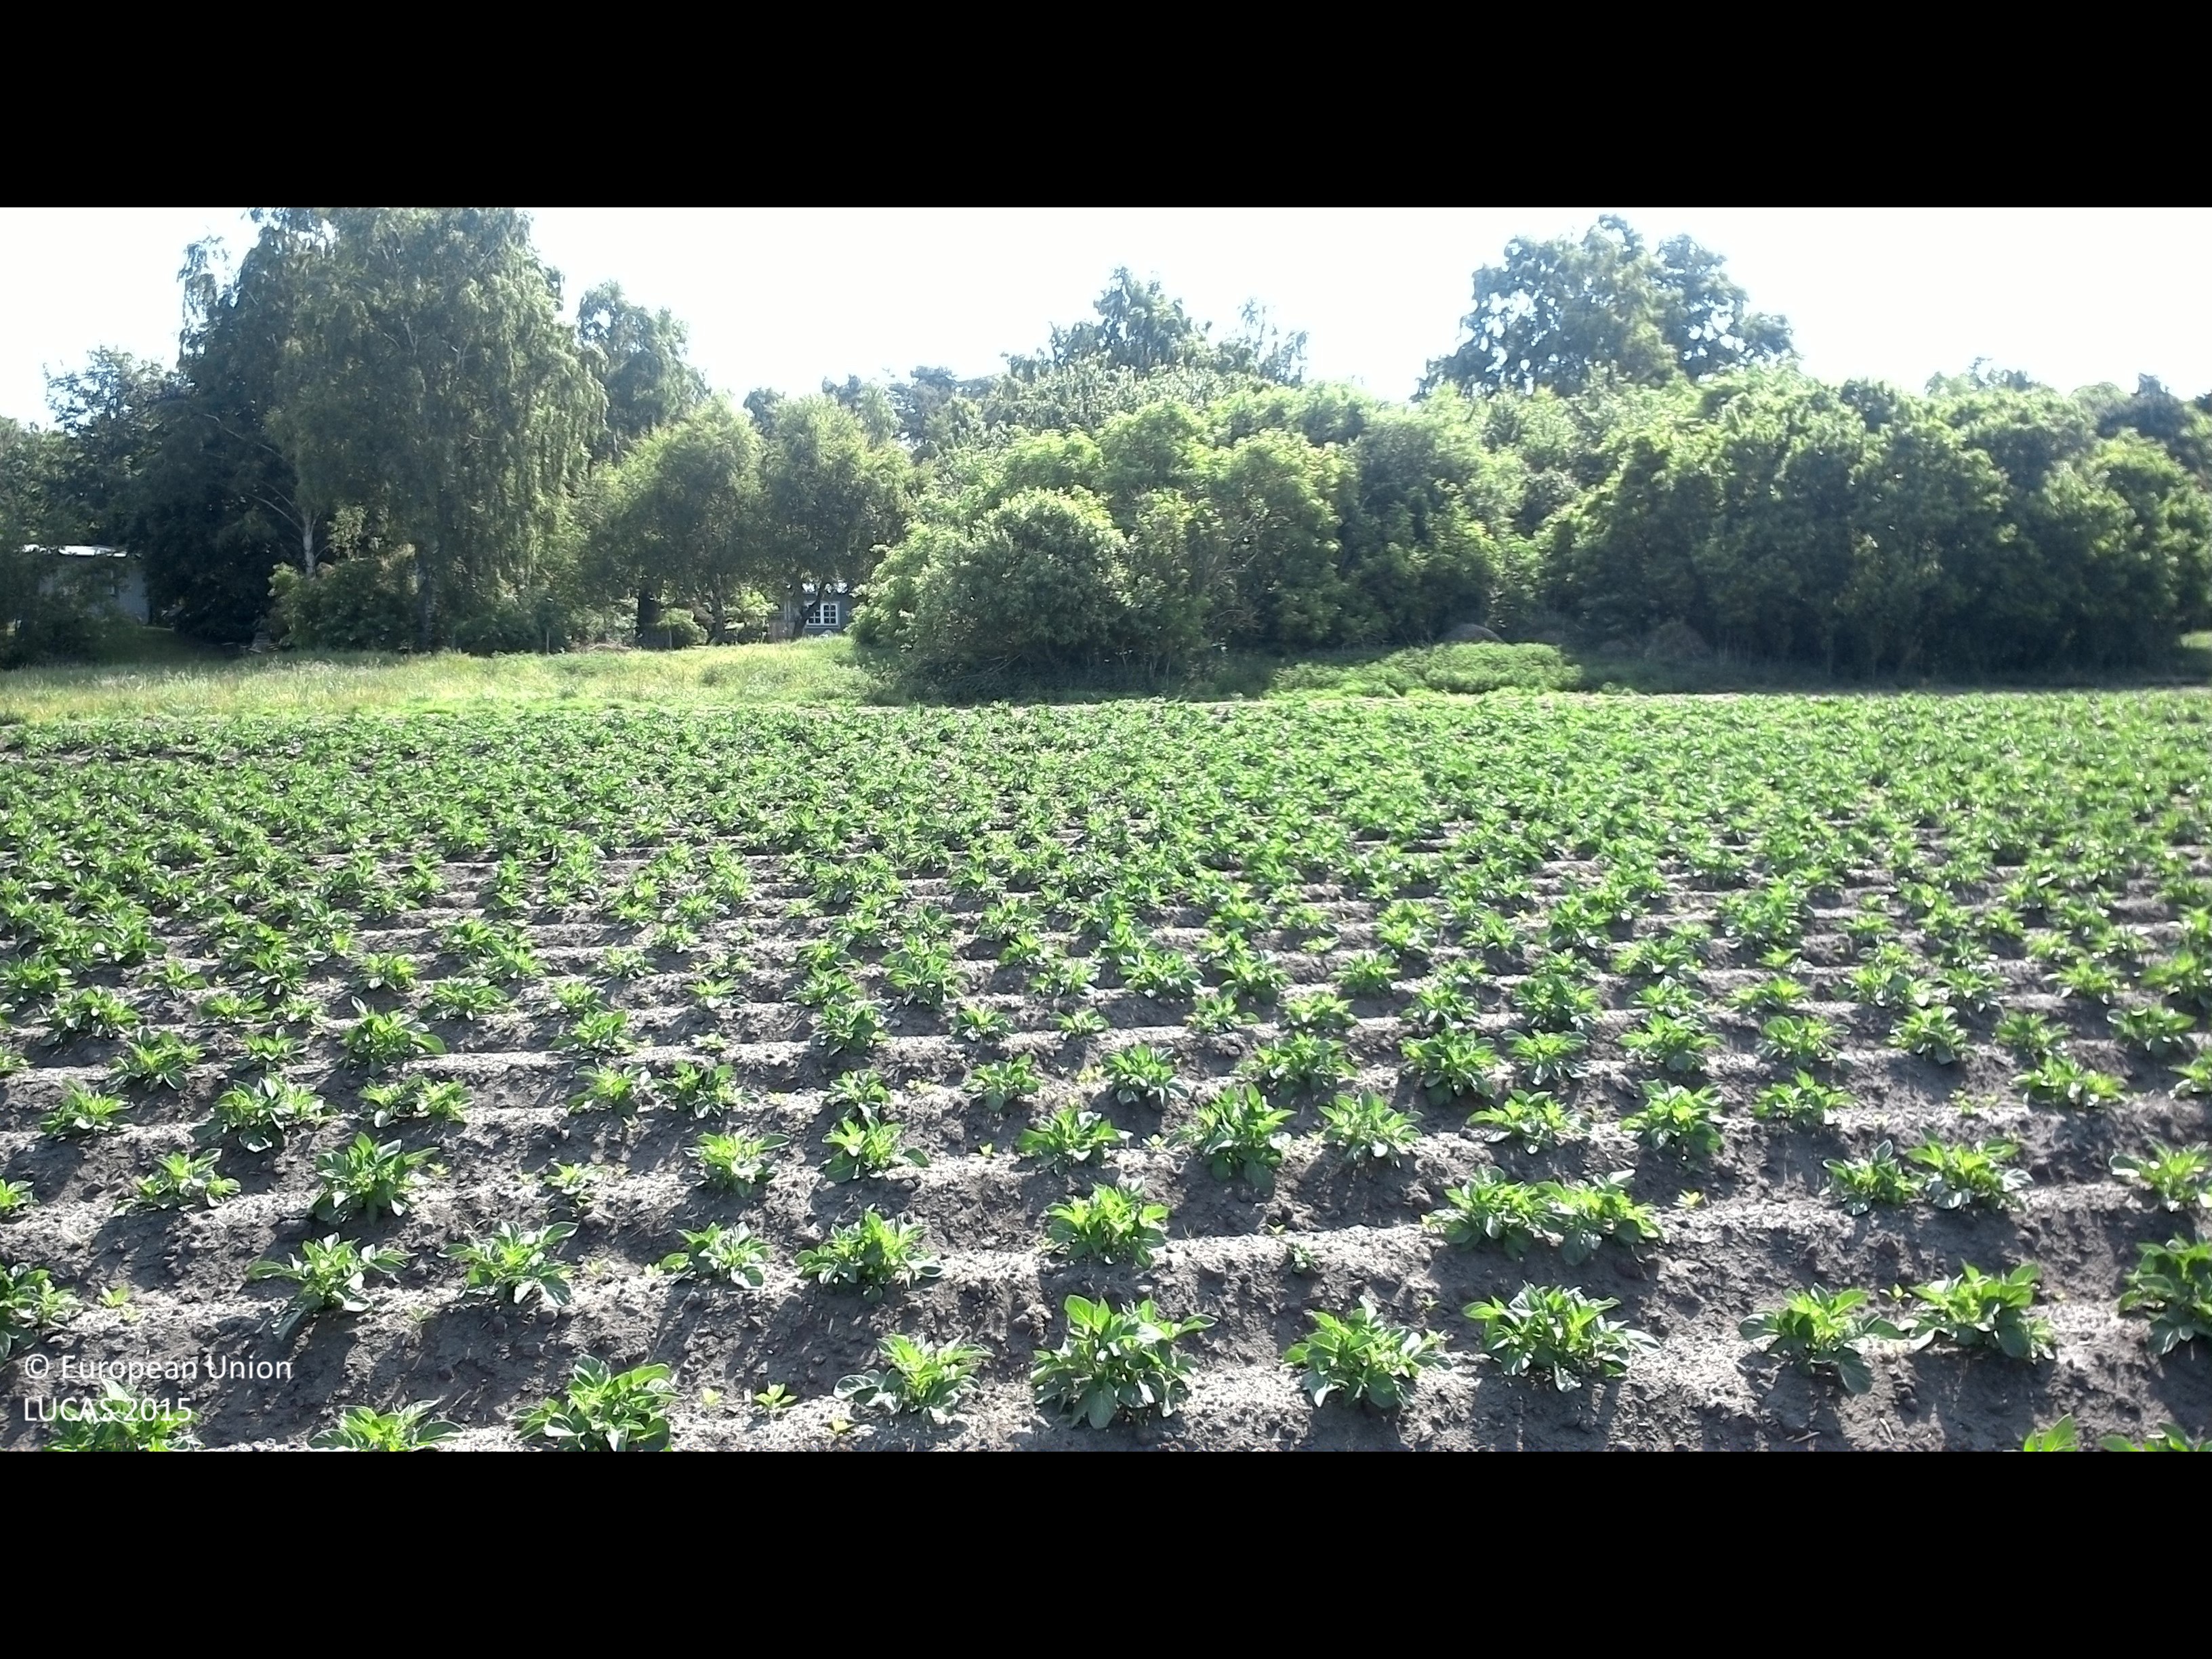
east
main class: Cropland
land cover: Potatoes
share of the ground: 50 - 75 %
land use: Agriculture (excluding fallow land and kitchen gardens)
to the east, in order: Potatoes; Broadleaved woodland; Artificial constructions in urban areas; Pine dominated mixed woodland
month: June
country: SE
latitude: 55.7953
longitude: 14.1933
